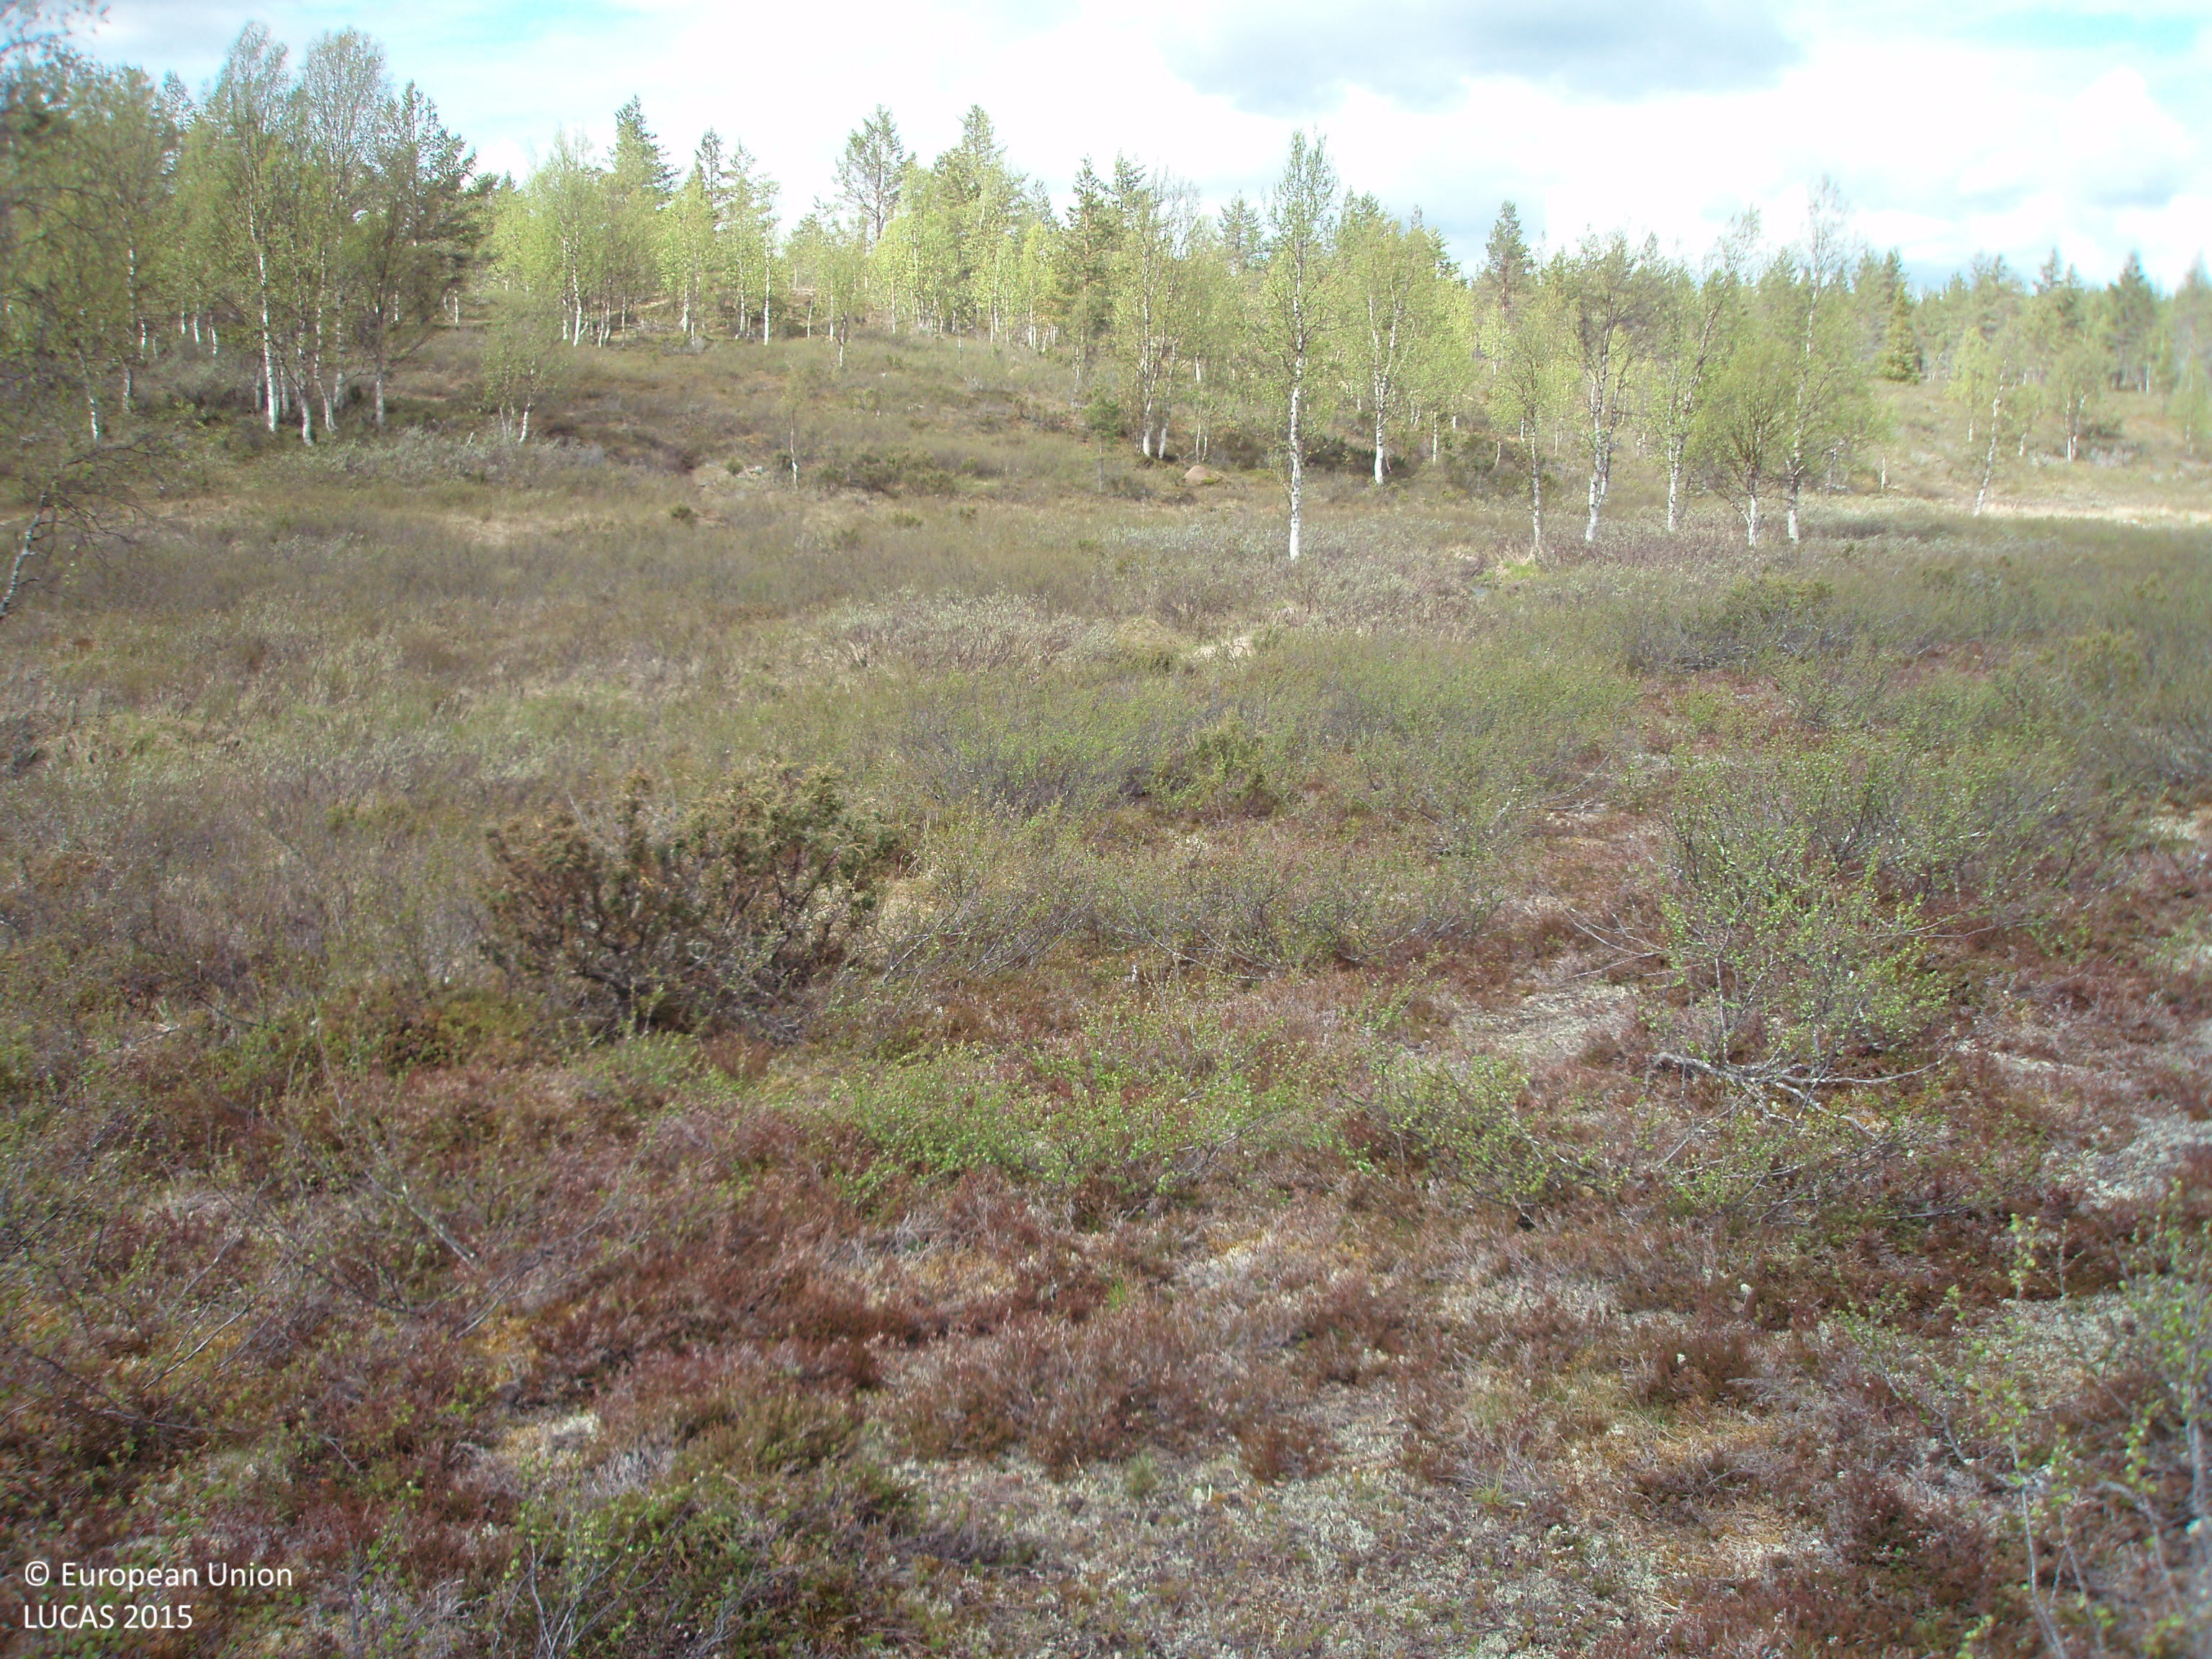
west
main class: Shrubland
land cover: Shrubland with sparse tree cover
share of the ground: > 75 %
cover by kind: shrubs 75 %, lichens and mosses 20 %, coniferous forest trees 5 %
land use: Semi-natural and natural areas not in use
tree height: > 5 m
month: June
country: FI
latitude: 68.3950
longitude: 26.9318
